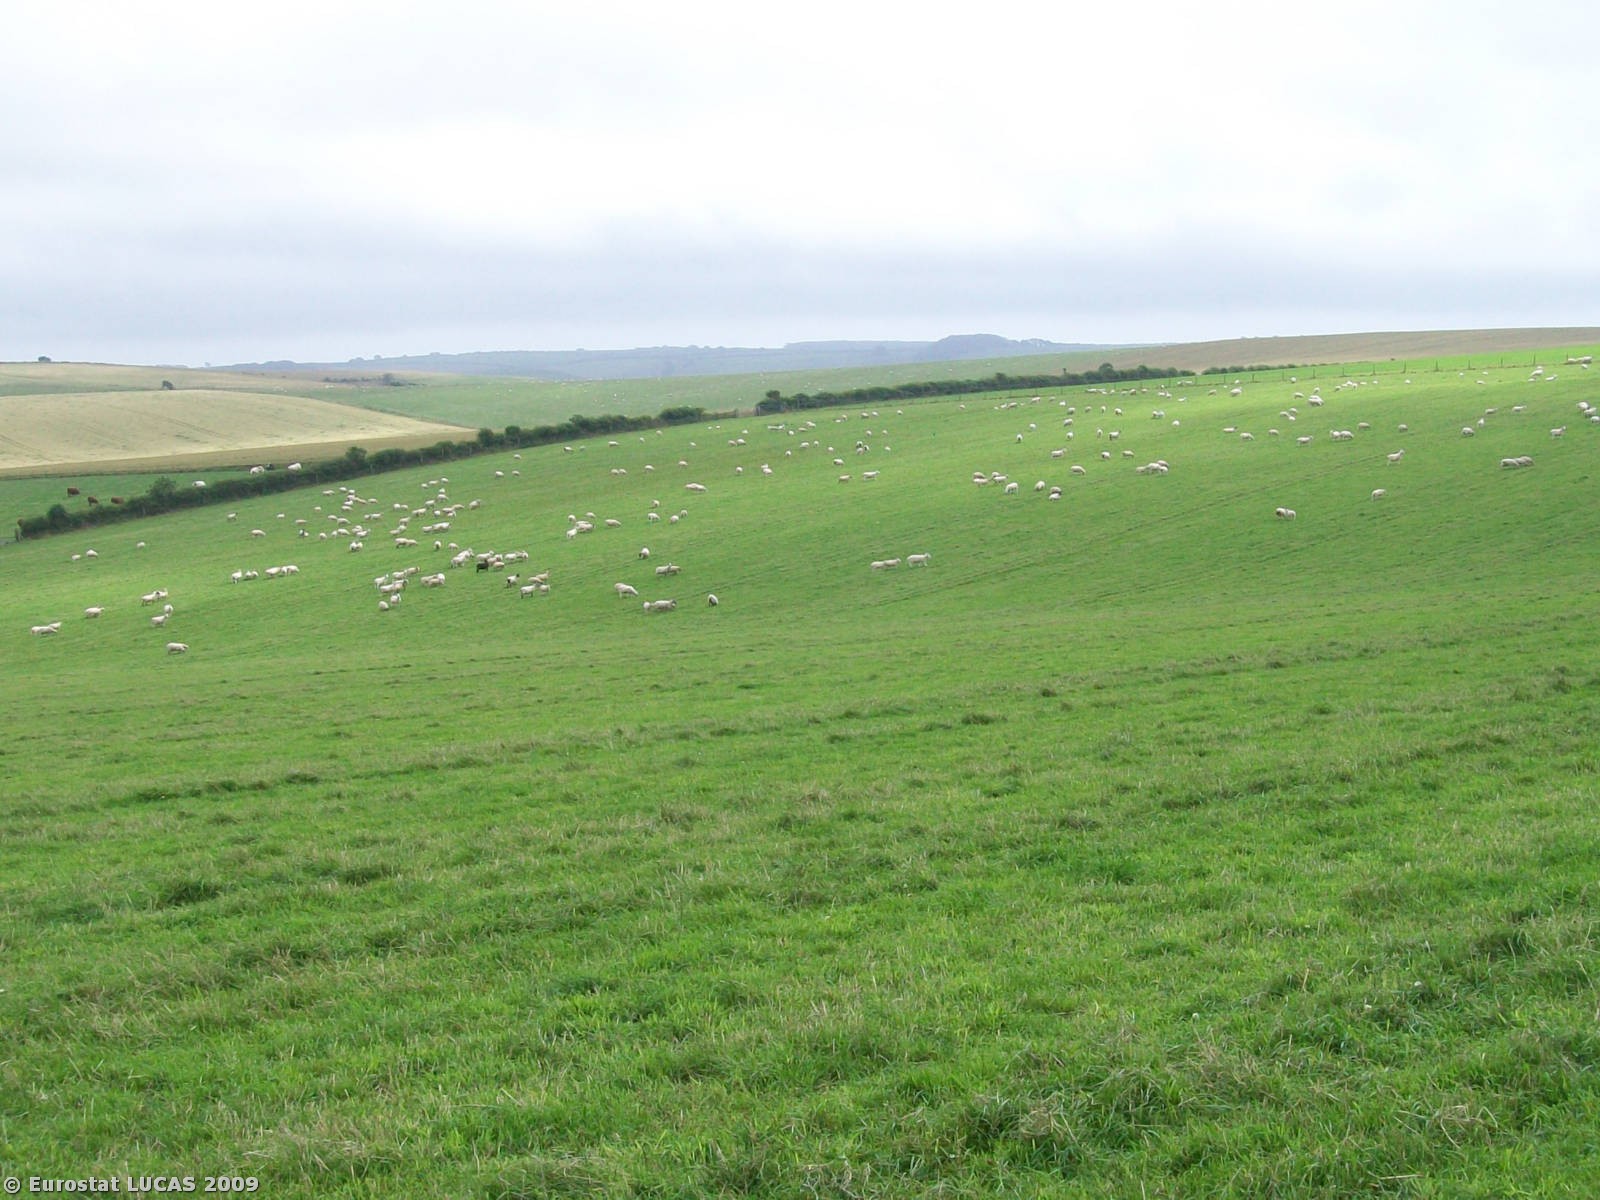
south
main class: Grassland
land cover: Grassland without tree/shrub cover
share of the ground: > 75 %
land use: Agriculture (excluding fallow land and kitchen gardens)
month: July
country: GB
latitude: 50.7193
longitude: -2.6031
